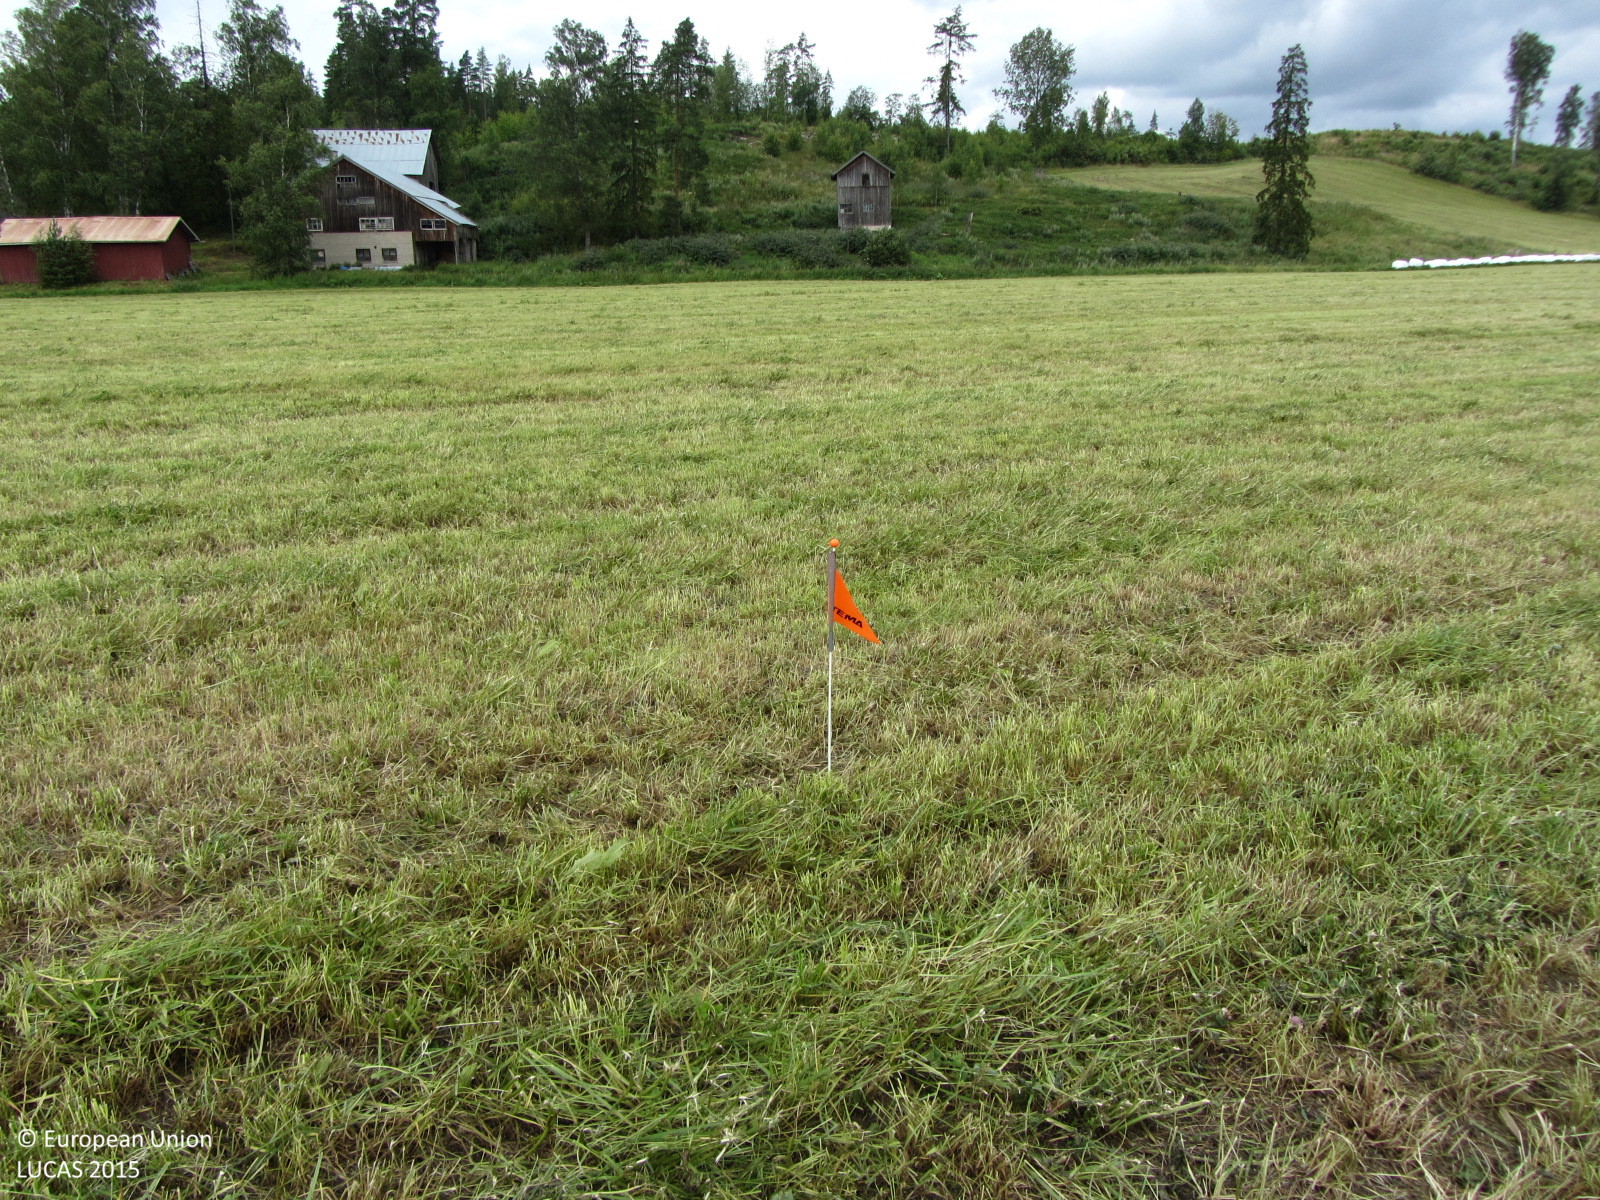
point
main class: Cropland
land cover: Temporary grasslands
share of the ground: > 75 %
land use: Agriculture (excluding fallow land and kitchen gardens)
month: July
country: FI
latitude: 60.4658
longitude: 24.3803
